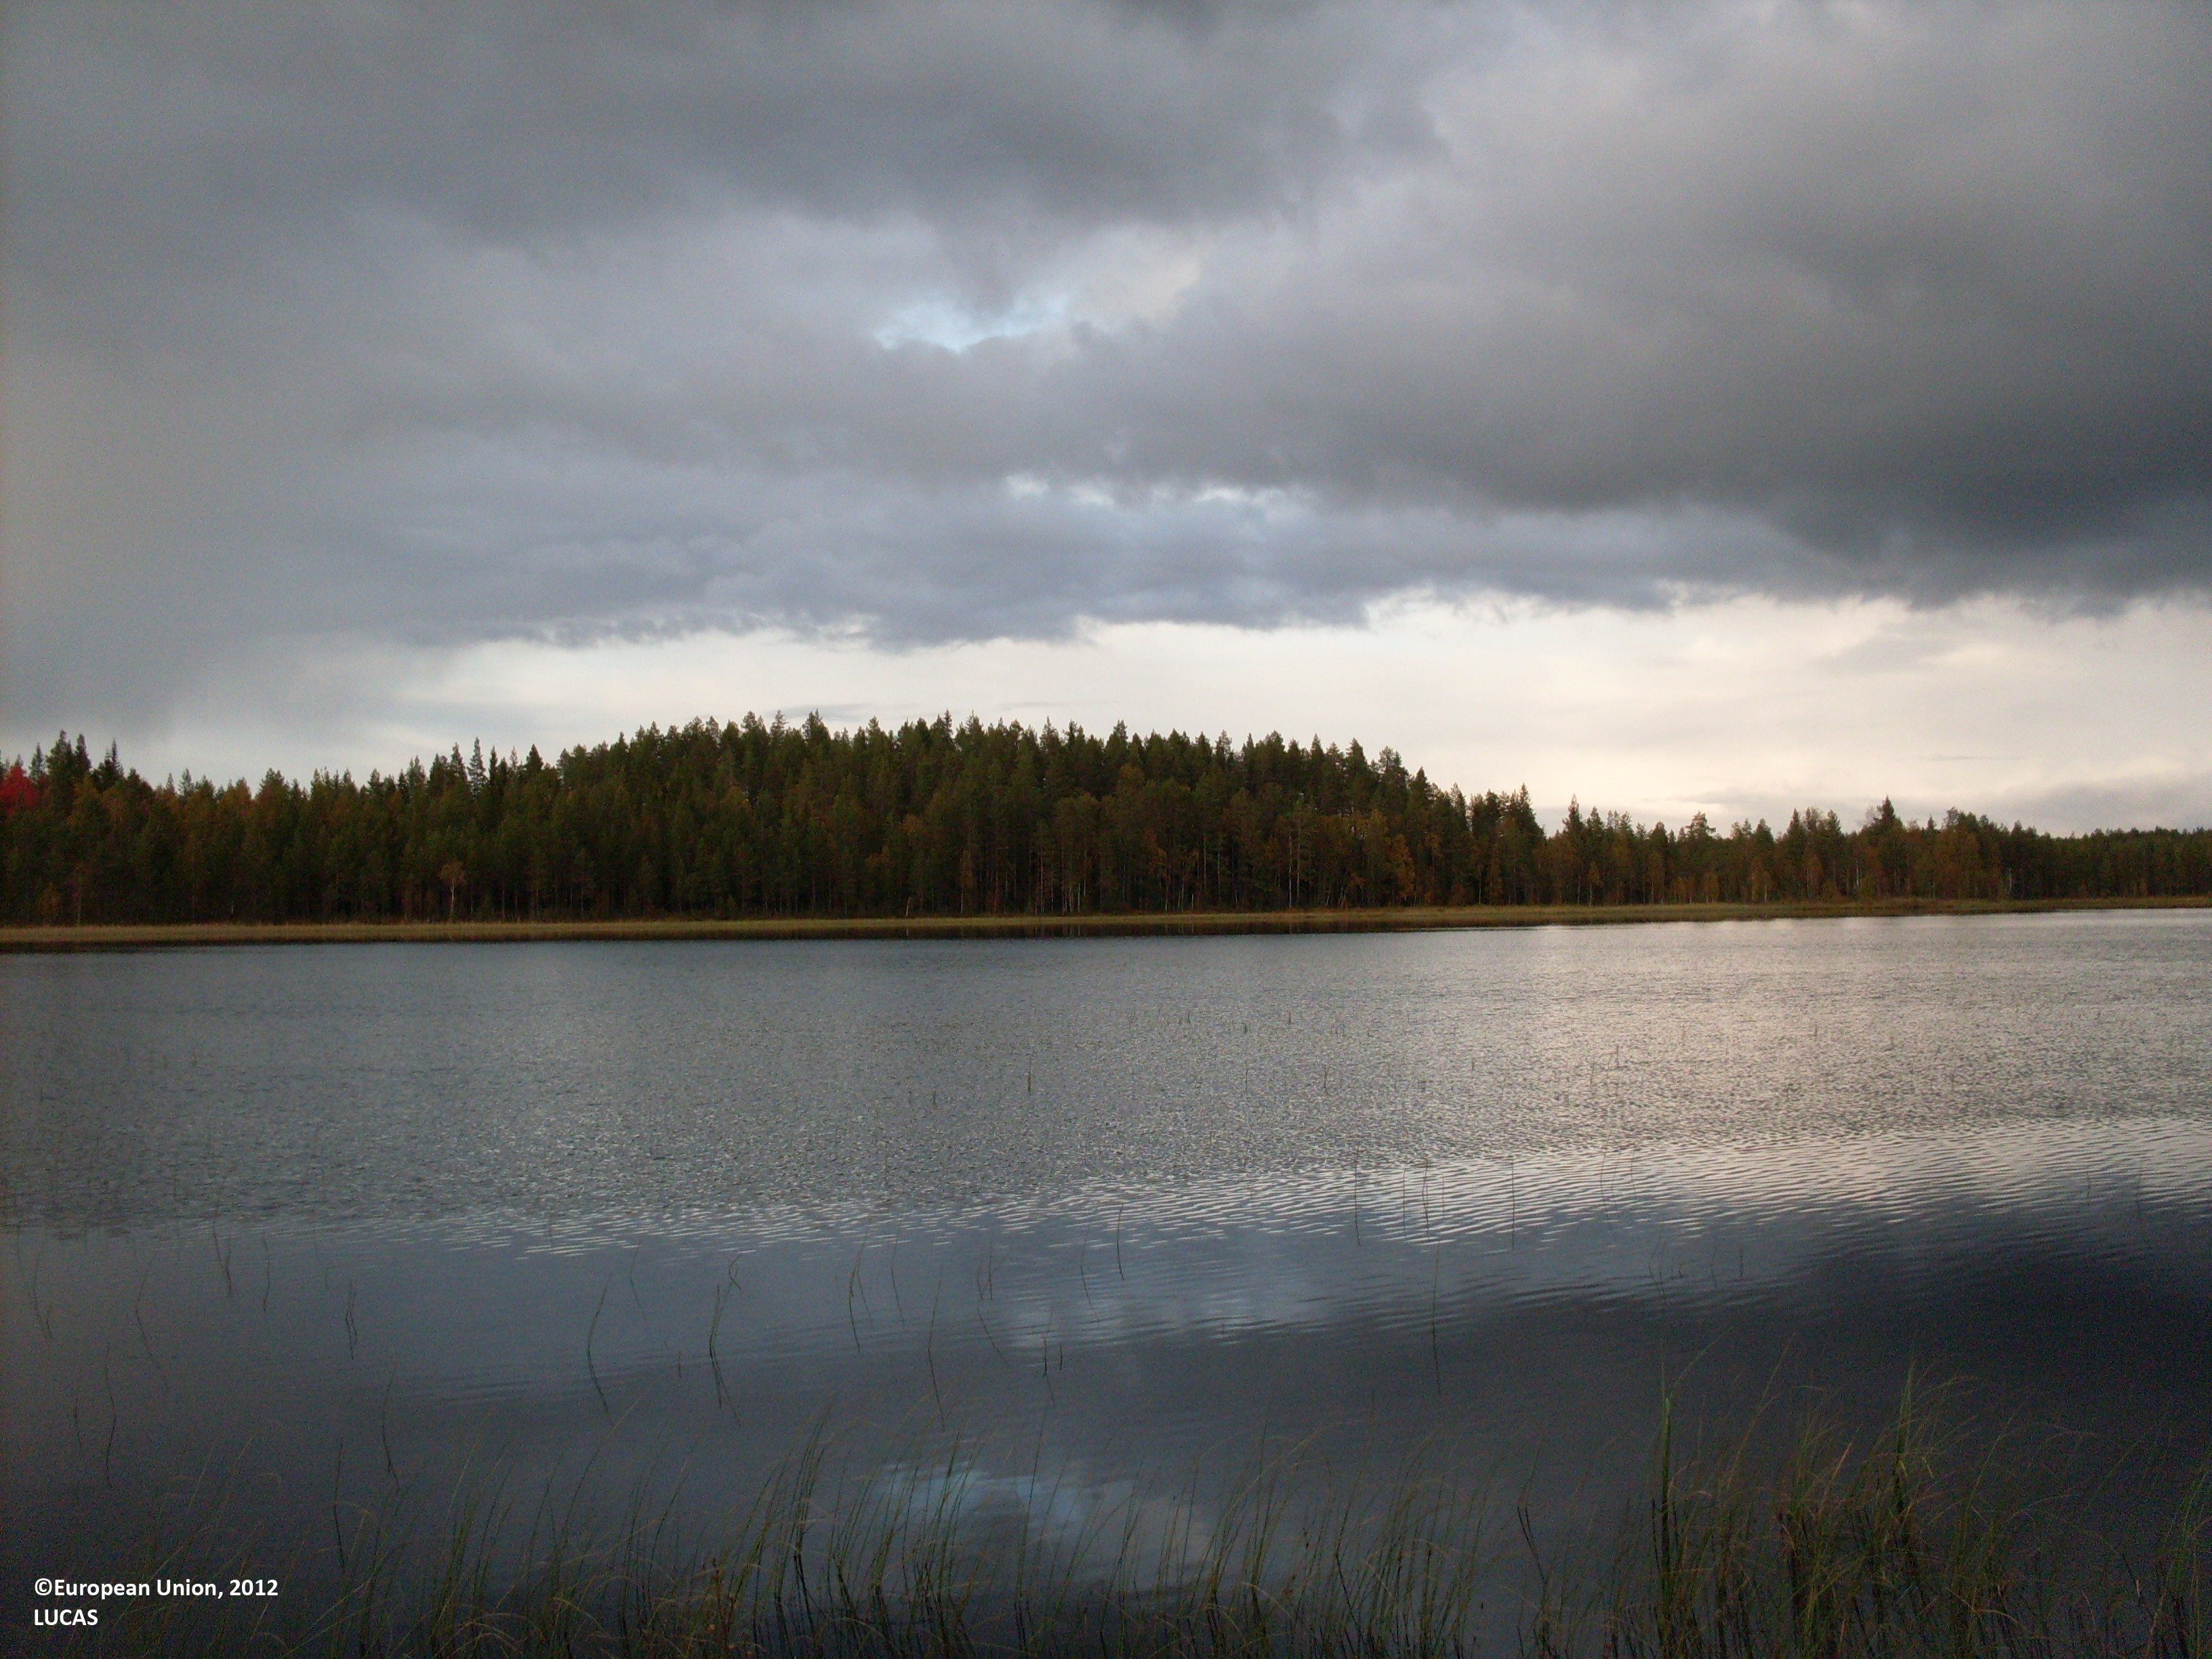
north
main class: Woodland
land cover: Pine dominated mixed woodland
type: boreal forest
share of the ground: 10 - 25 %
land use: Forestry
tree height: > 5 m
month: September
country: FI
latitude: 64.0355
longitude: 30.0384
